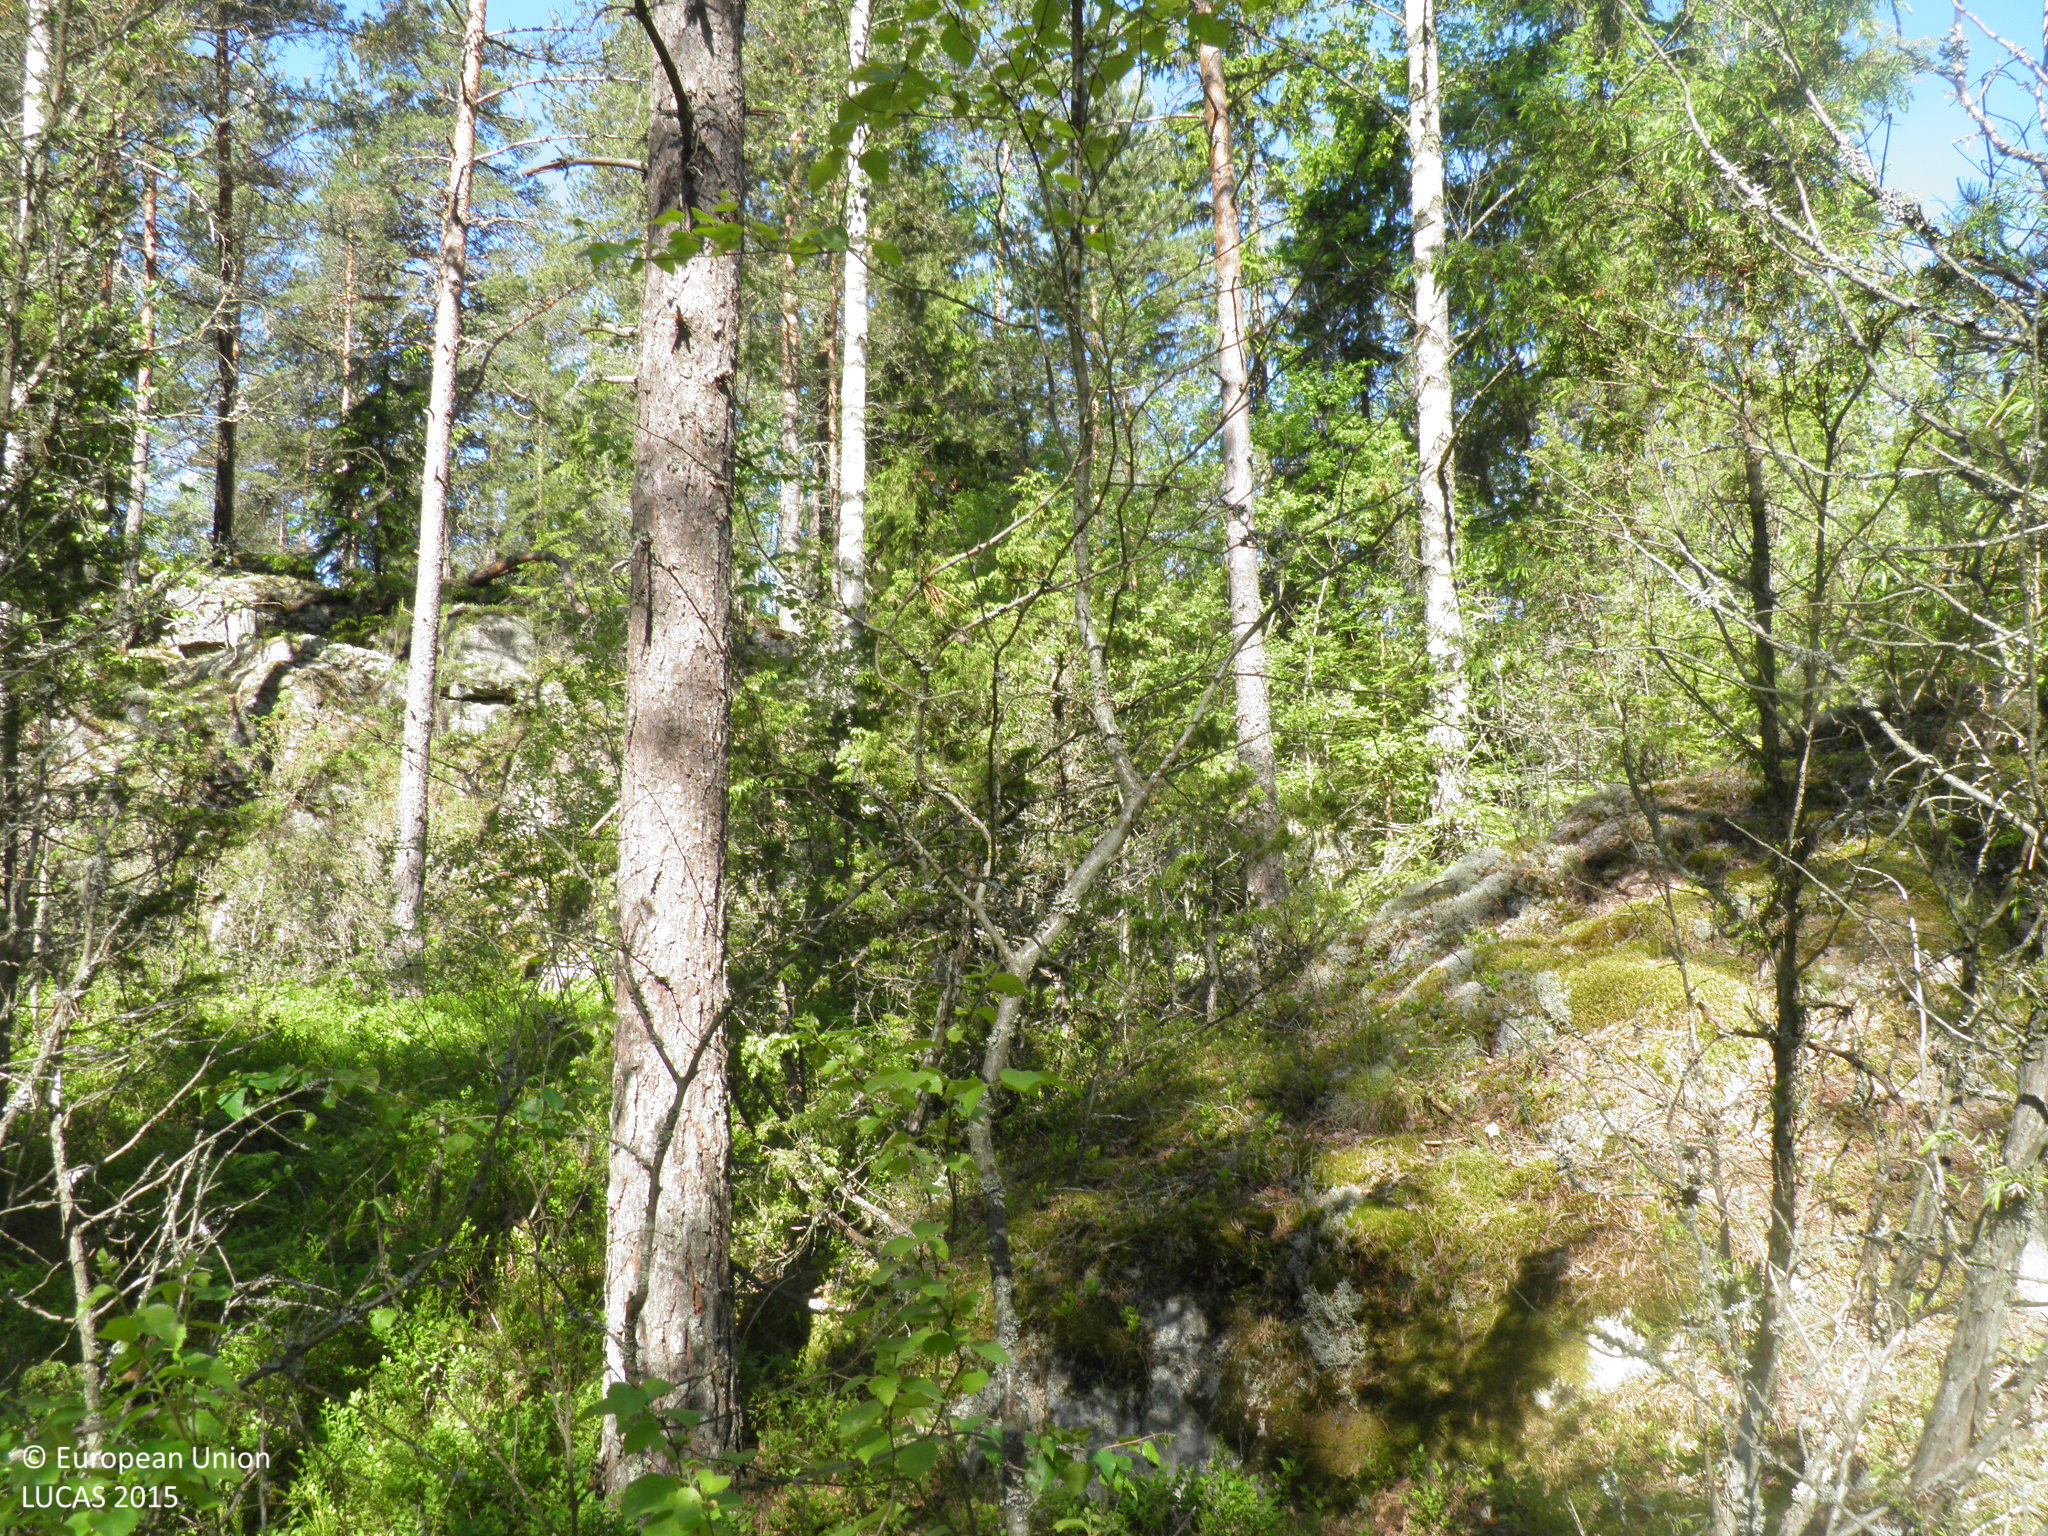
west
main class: Woodland
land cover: Other coniferous woodland
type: hemiboreal forest and nemoral coniferous forest and mixed broadleaved-coniferous forest
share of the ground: 50 - 75 %
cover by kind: coniferous forest trees 60 %, shrubs 15 %, herbaceous plants 15 %, broadleaved forest trees 10 %
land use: Forestry
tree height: > 5 m
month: June
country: FI
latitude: 60.4148
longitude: 22.6197
